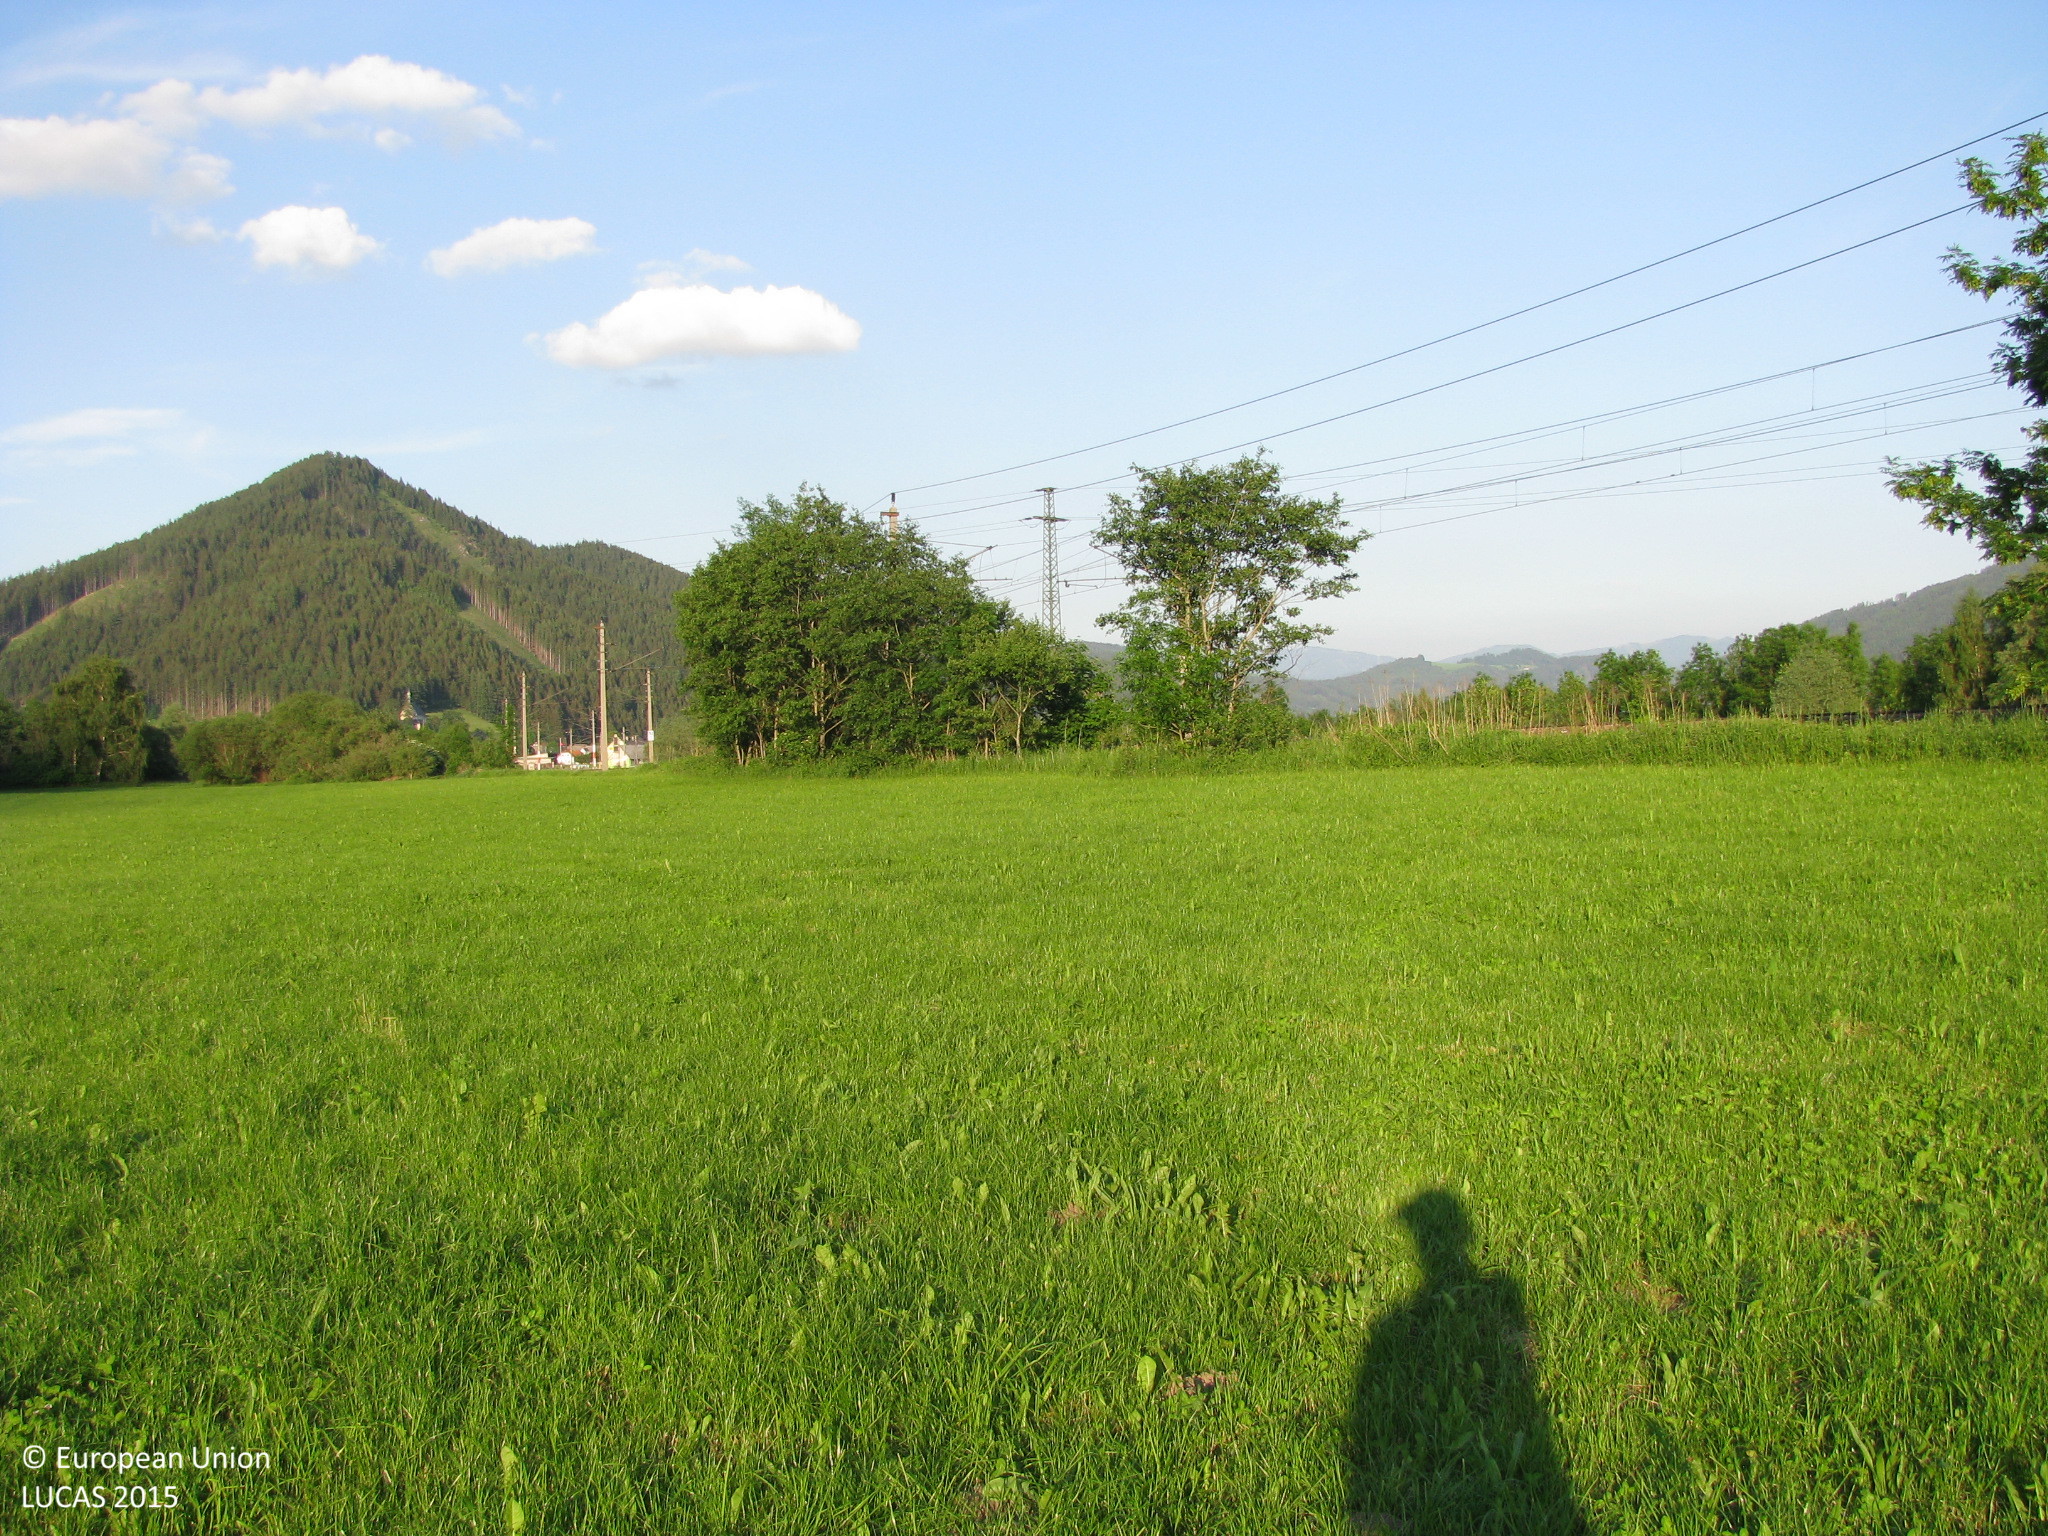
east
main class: Grassland
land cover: Grassland without tree/shrub cover
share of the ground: > 75 %
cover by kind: herbaceous plants 100 %
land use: Agriculture (excluding fallow land and kitchen gardens)
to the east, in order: Grassland without tree/shrub cover; Spontaneously vegetated surfaces; Electric lines; Railways; Spontaneously vegetated surfaces
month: June
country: AT
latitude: 47.3927
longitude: 14.9147
